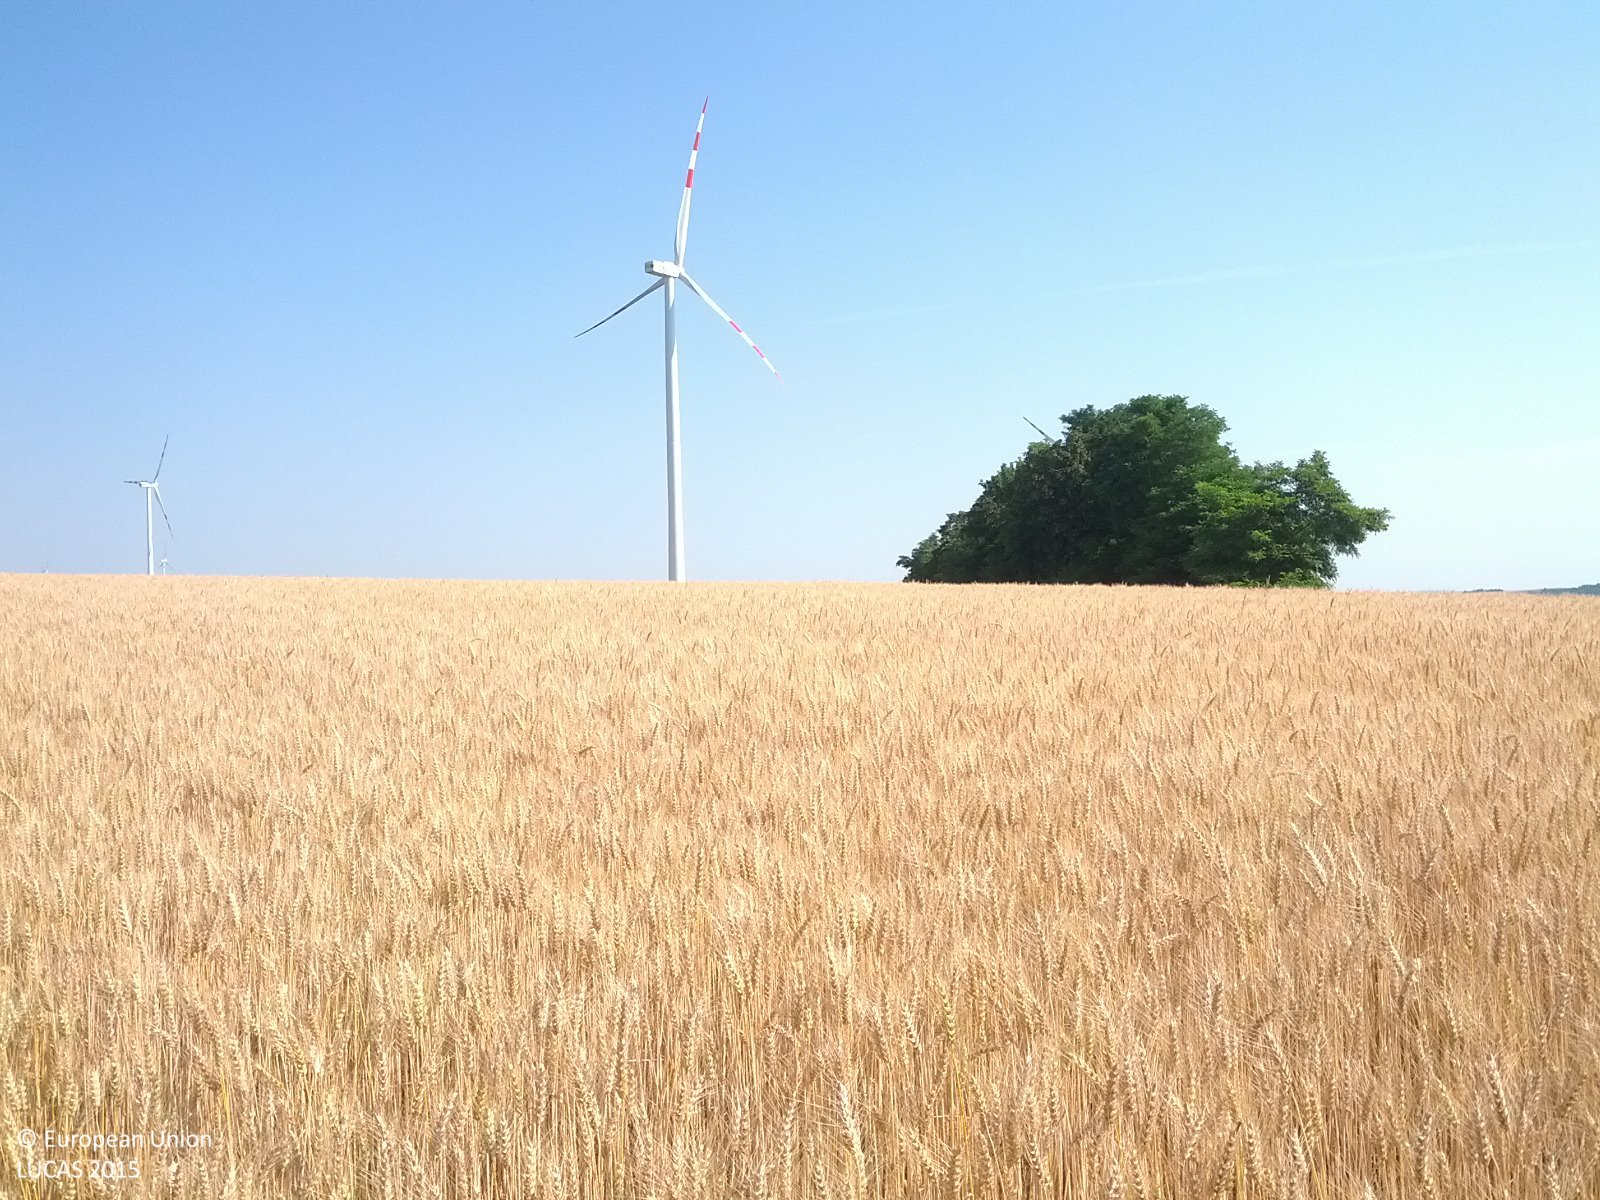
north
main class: Cropland
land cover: Cherry fruit
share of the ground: 25 - 50 %
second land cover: Grassland without tree/shrub cover
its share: 50 - 75 %
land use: Agriculture (excluding fallow land and kitchen gardens)
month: July
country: AT
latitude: 48.6011
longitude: 16.6379
